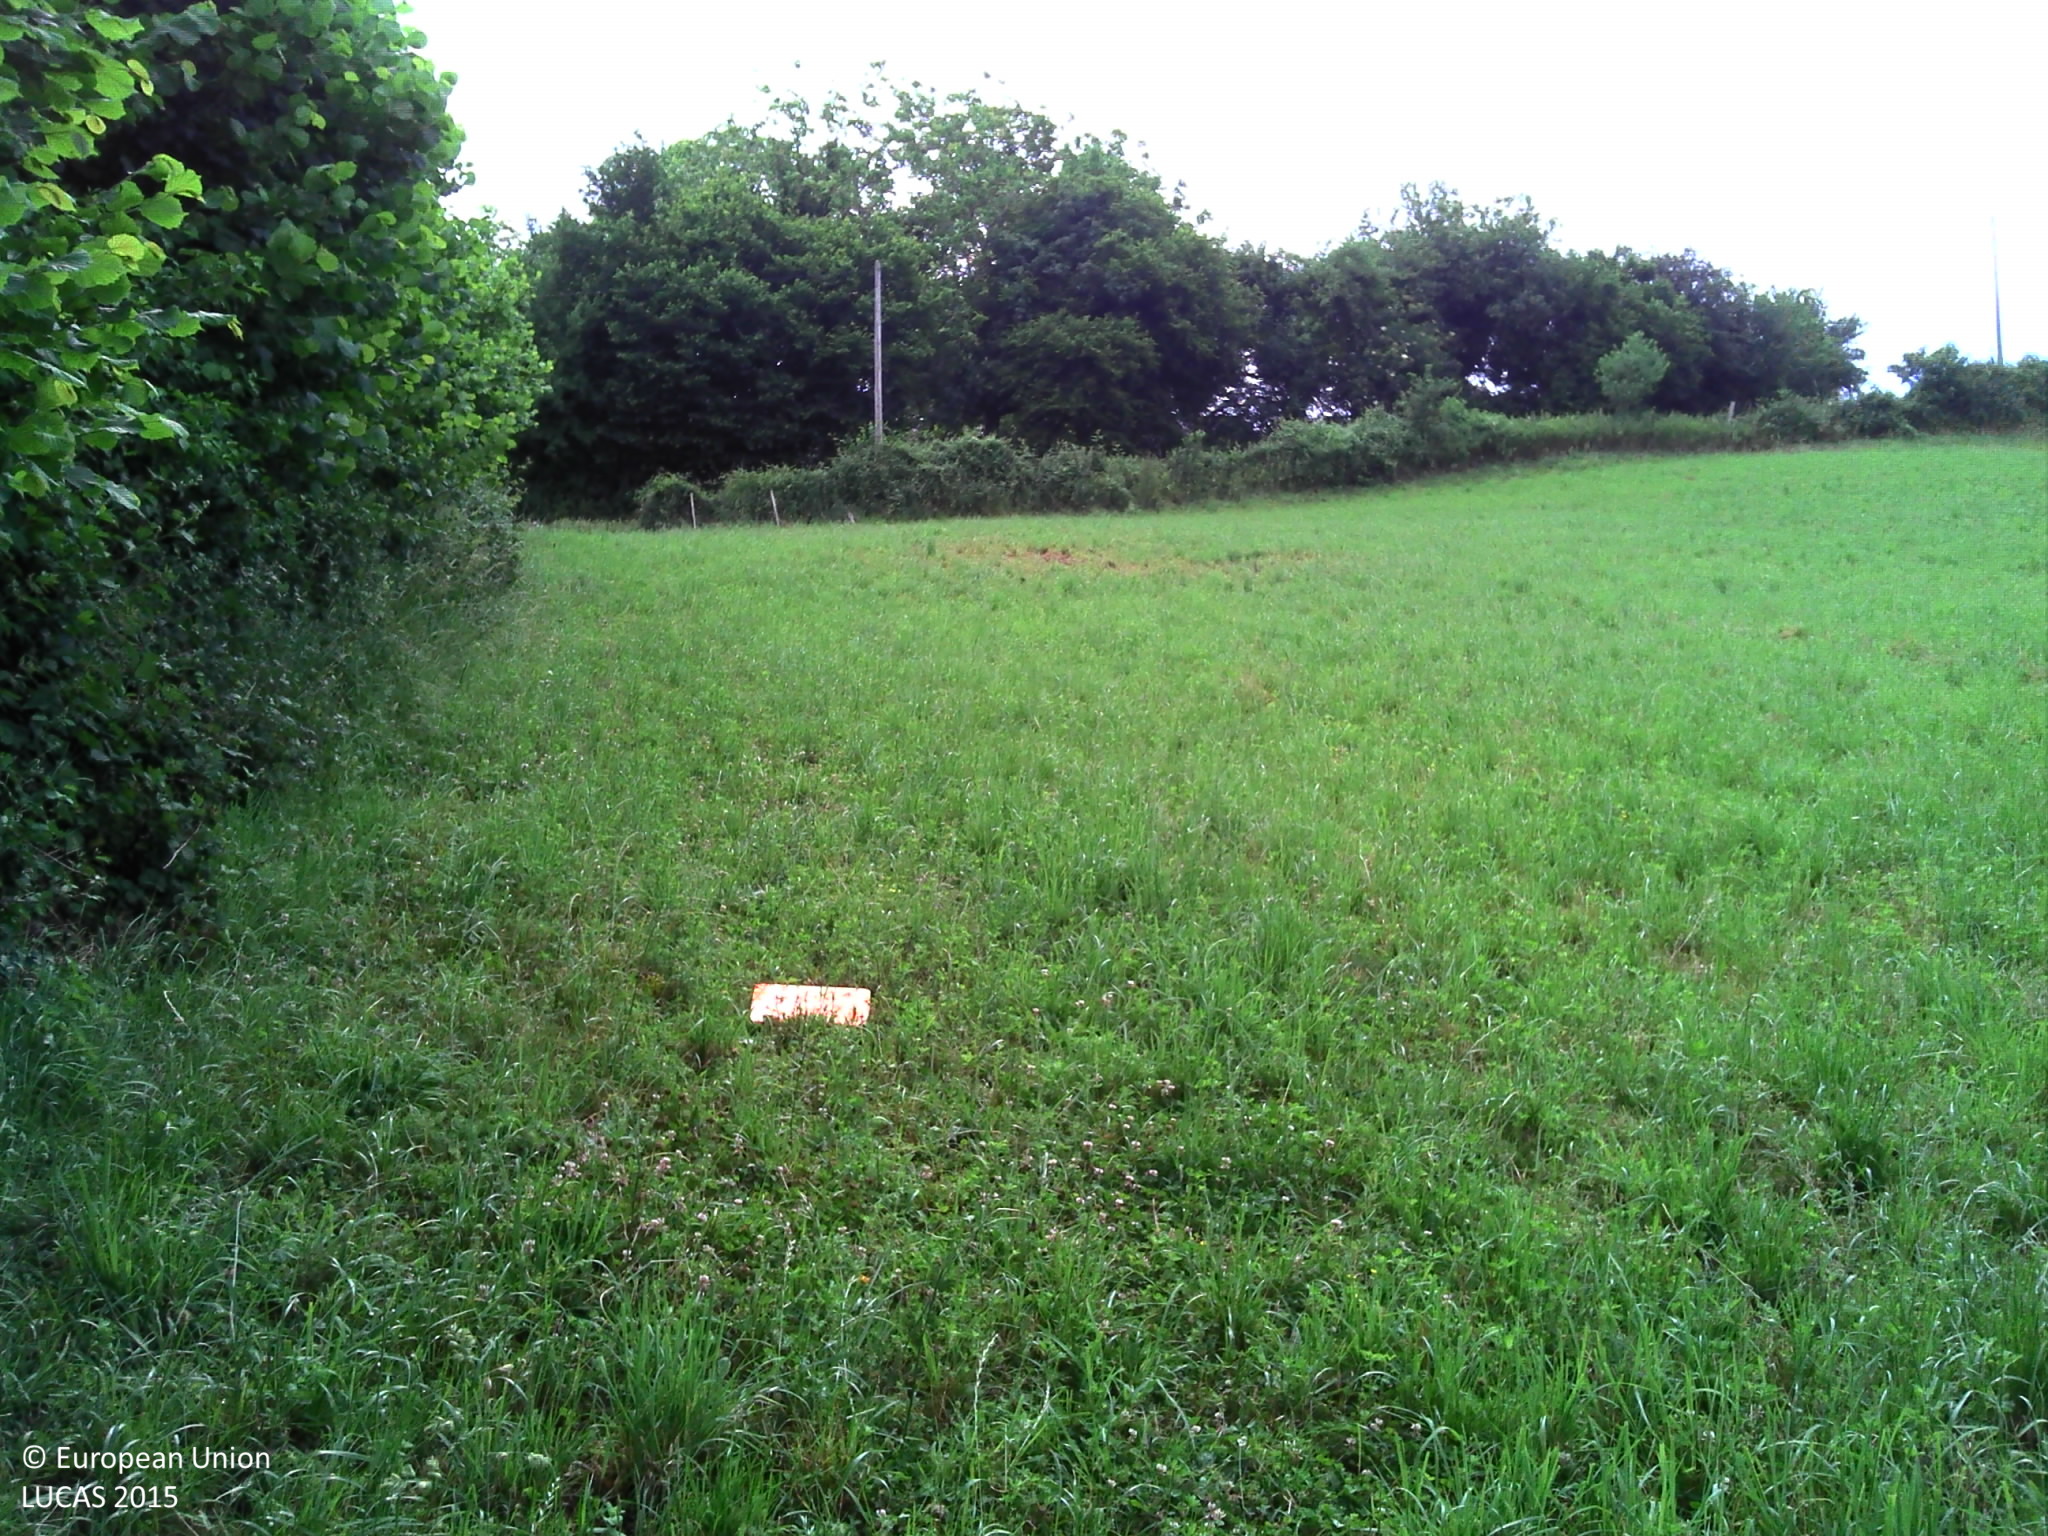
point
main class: Cropland
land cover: Barley
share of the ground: > 75 %
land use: Agriculture (excluding fallow land and kitchen gardens)
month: June
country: FR
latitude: 44.2062
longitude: 2.5077
